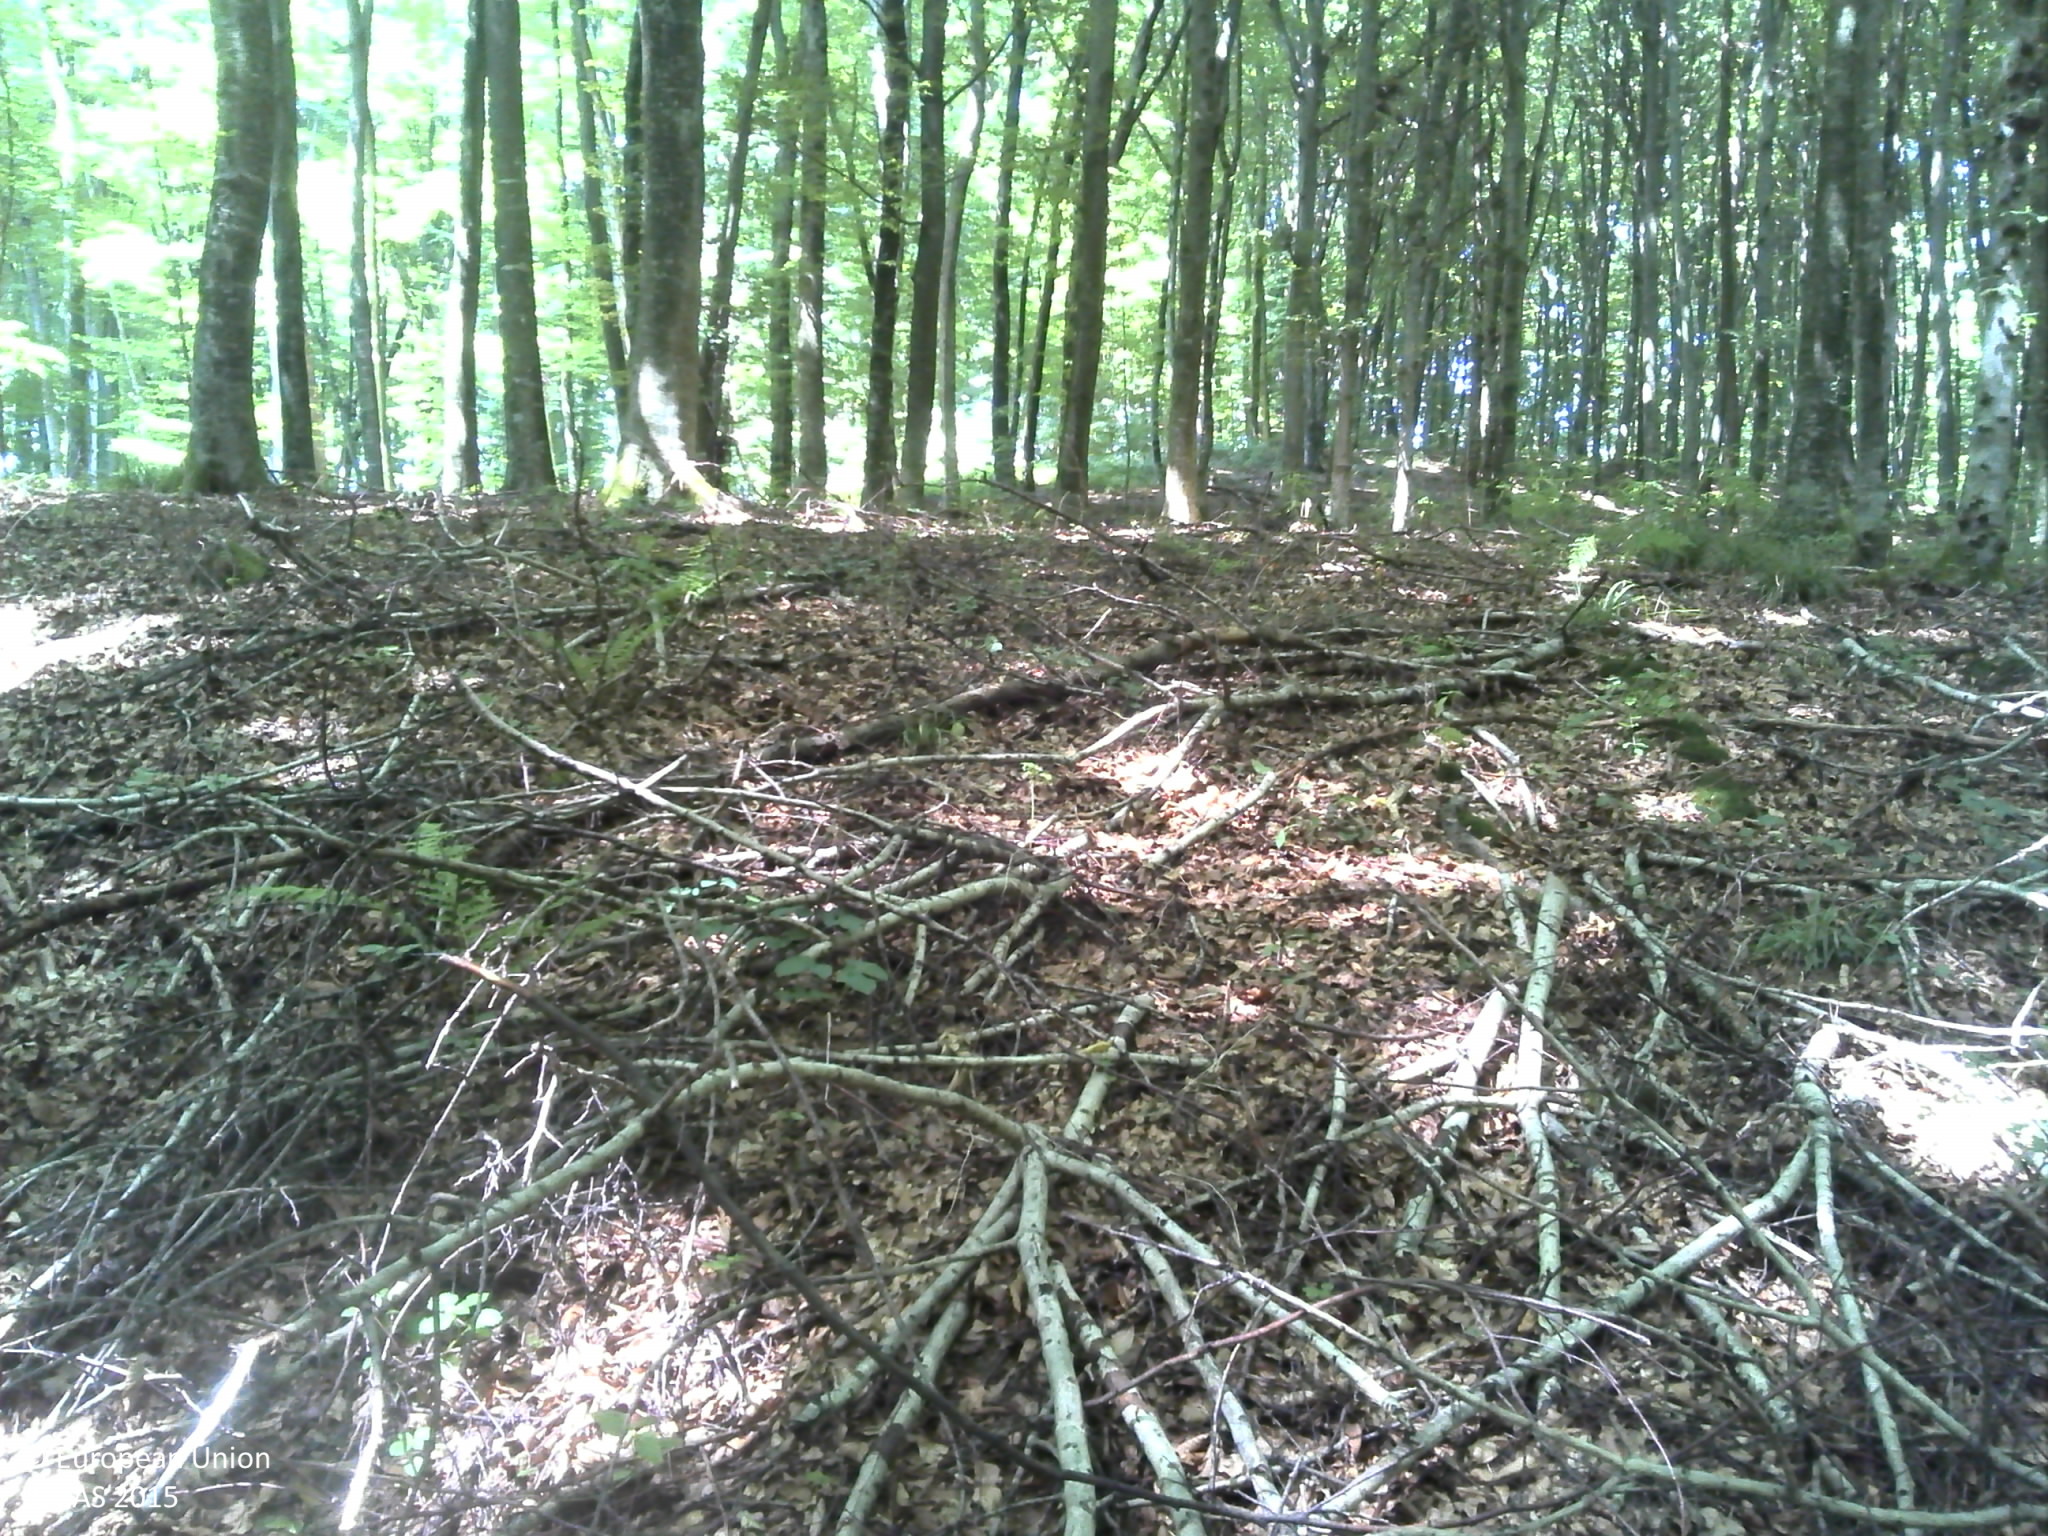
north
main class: Woodland
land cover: Broadleaved woodland
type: acidophilous oak and oak-birch forest
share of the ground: > 75 %
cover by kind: broadleaved forest trees 90 %, shrubs 5 %, herbaceous plants 5 %
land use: Forestry
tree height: > 5 m
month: July
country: HR
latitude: 45.5505
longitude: 17.1607
